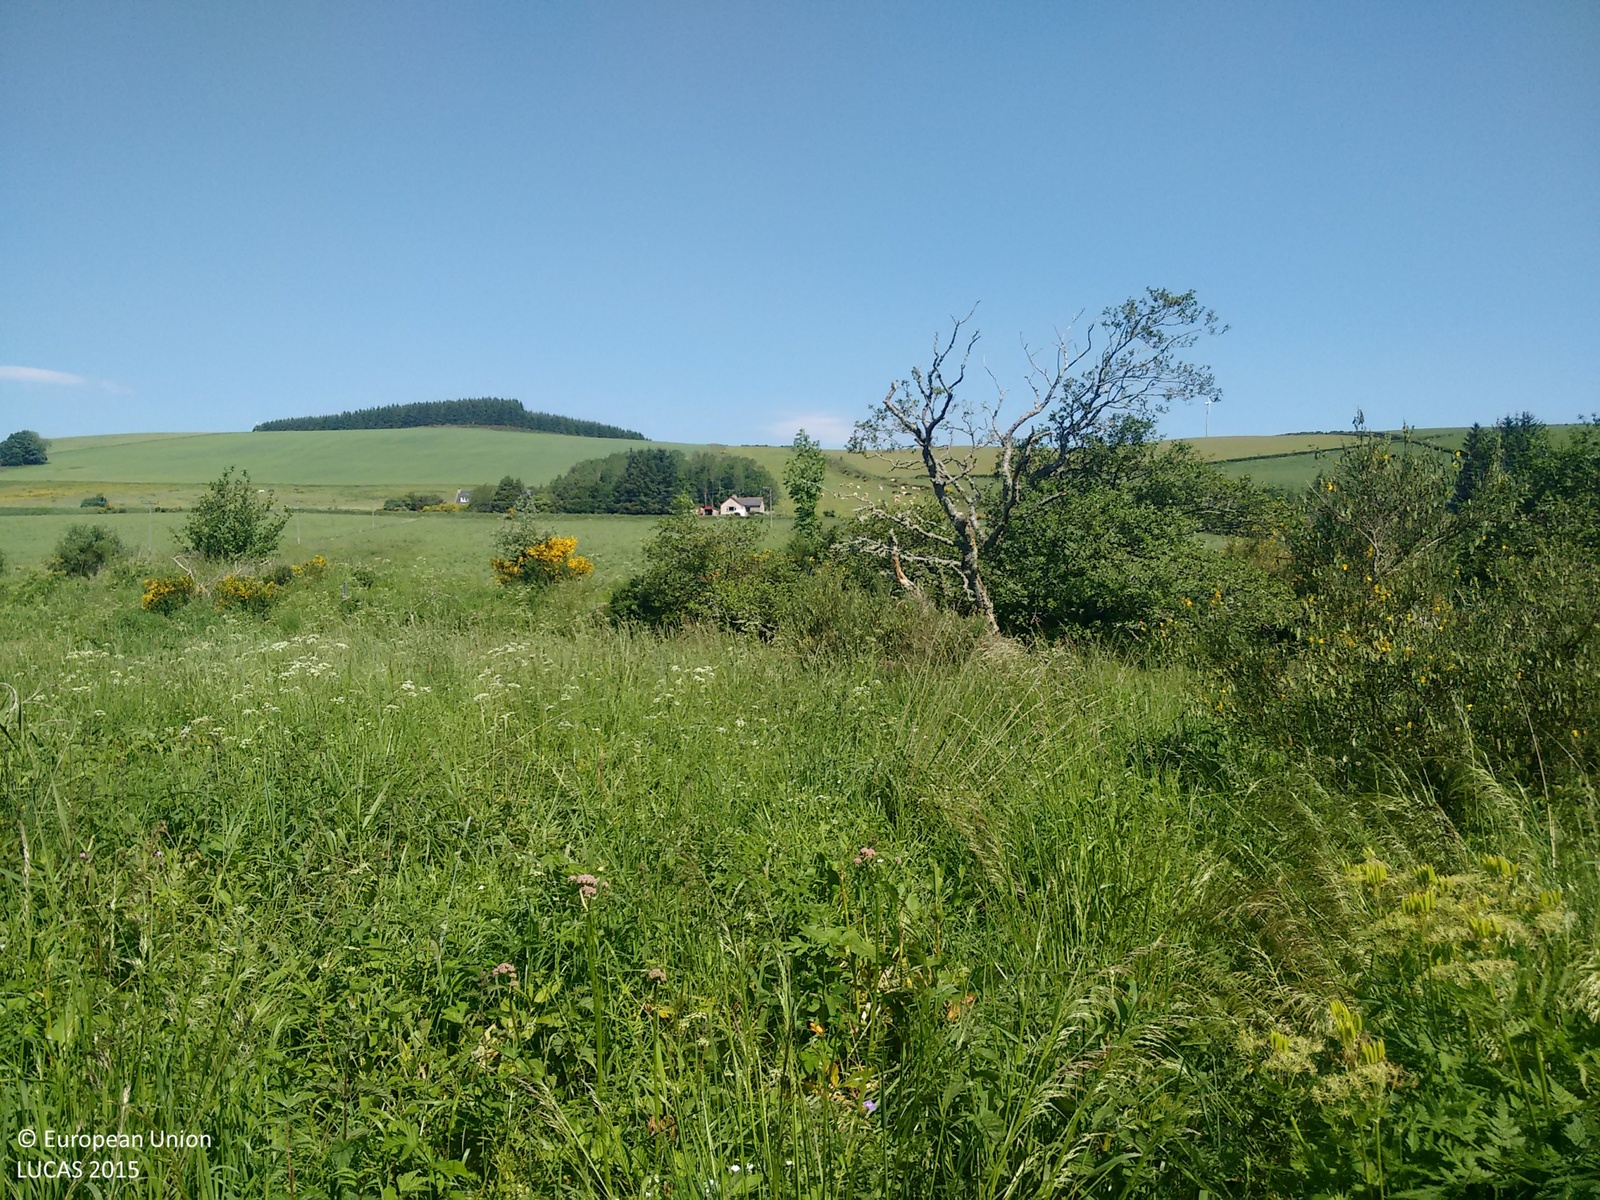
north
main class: Woodland
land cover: Broadleaved woodland
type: mesophytic deciduous forest
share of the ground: > 75 %
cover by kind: herbaceous plants 60 %, broadleaved forest trees 30 %, shrubs 10 %
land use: Semi-natural and natural areas not in use
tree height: > 5 m
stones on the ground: < 10 %
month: July
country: GB
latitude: 57.4509
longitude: -2.8745
